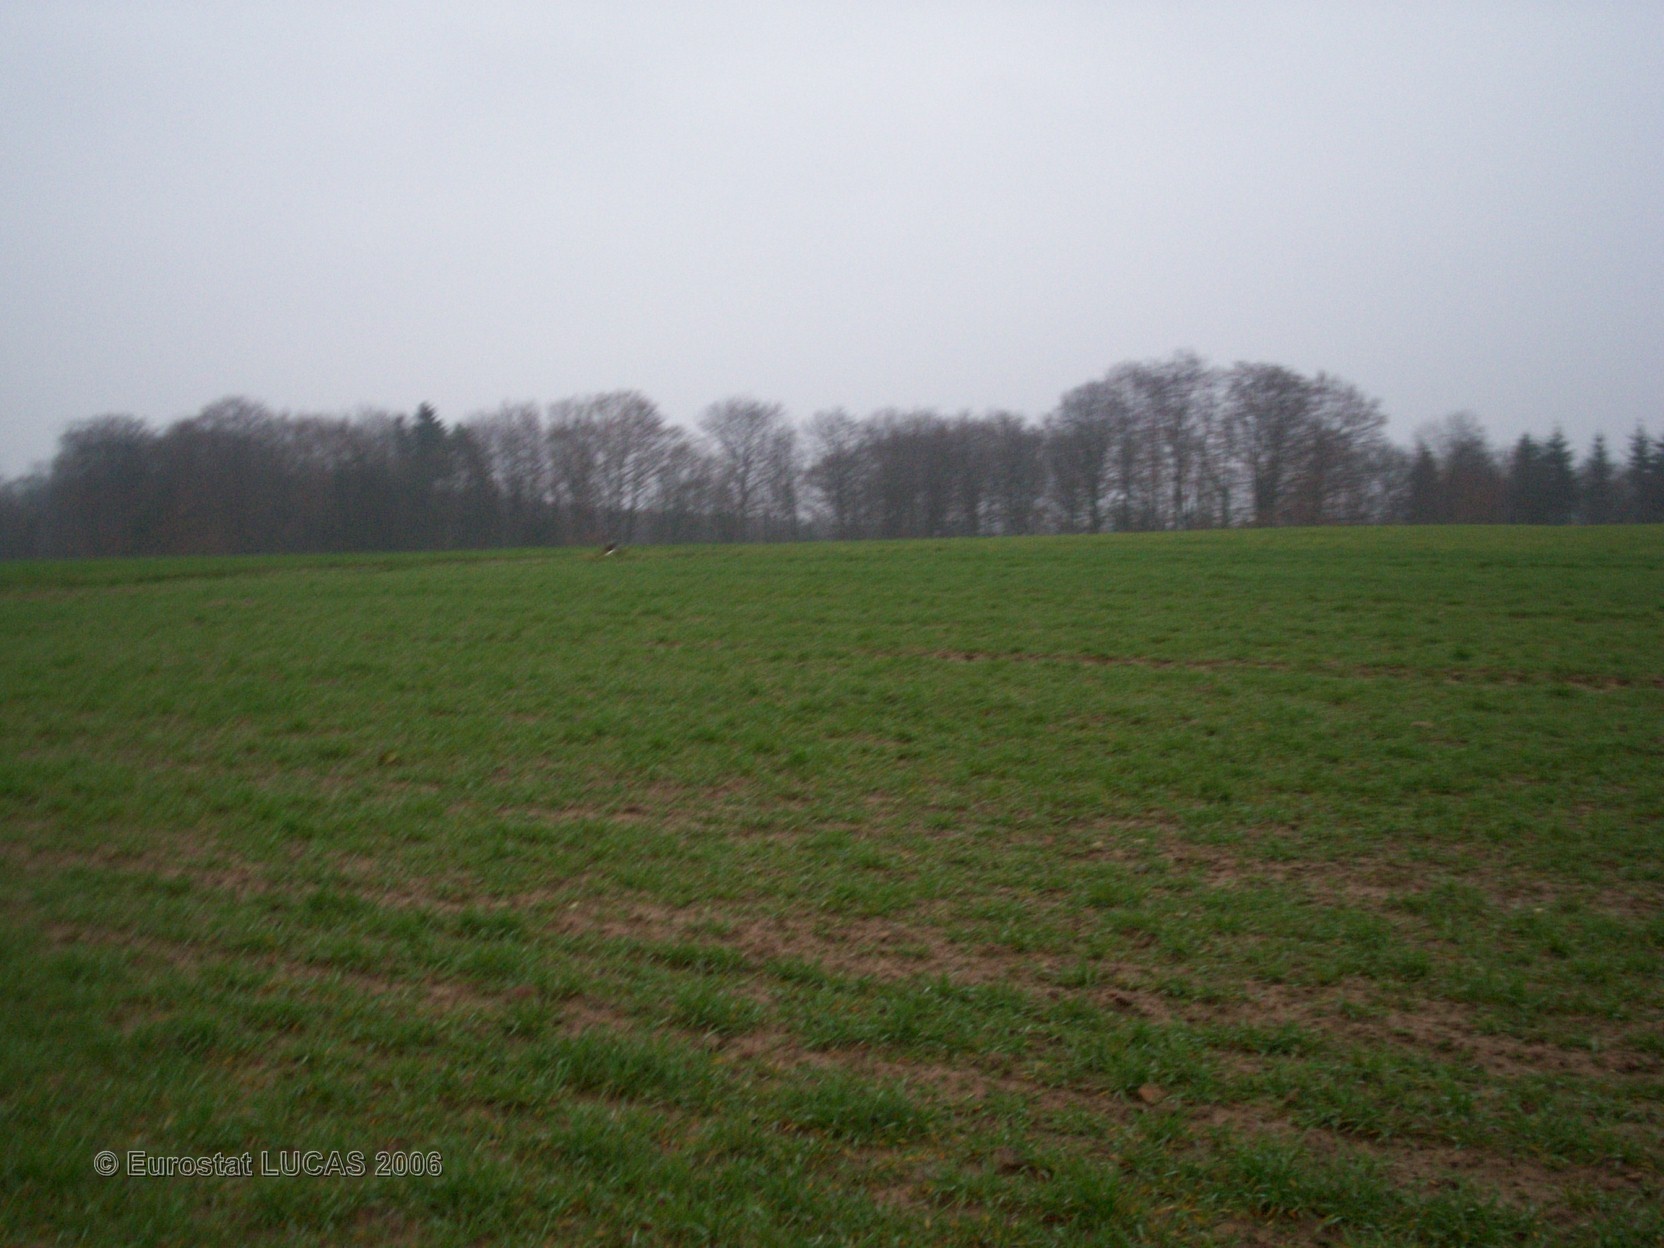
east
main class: Cropland
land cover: Common wheat
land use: Agriculture (excluding fallow land and kitchen gardens)
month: April
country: FR
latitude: 48.1238
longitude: 6.2524
